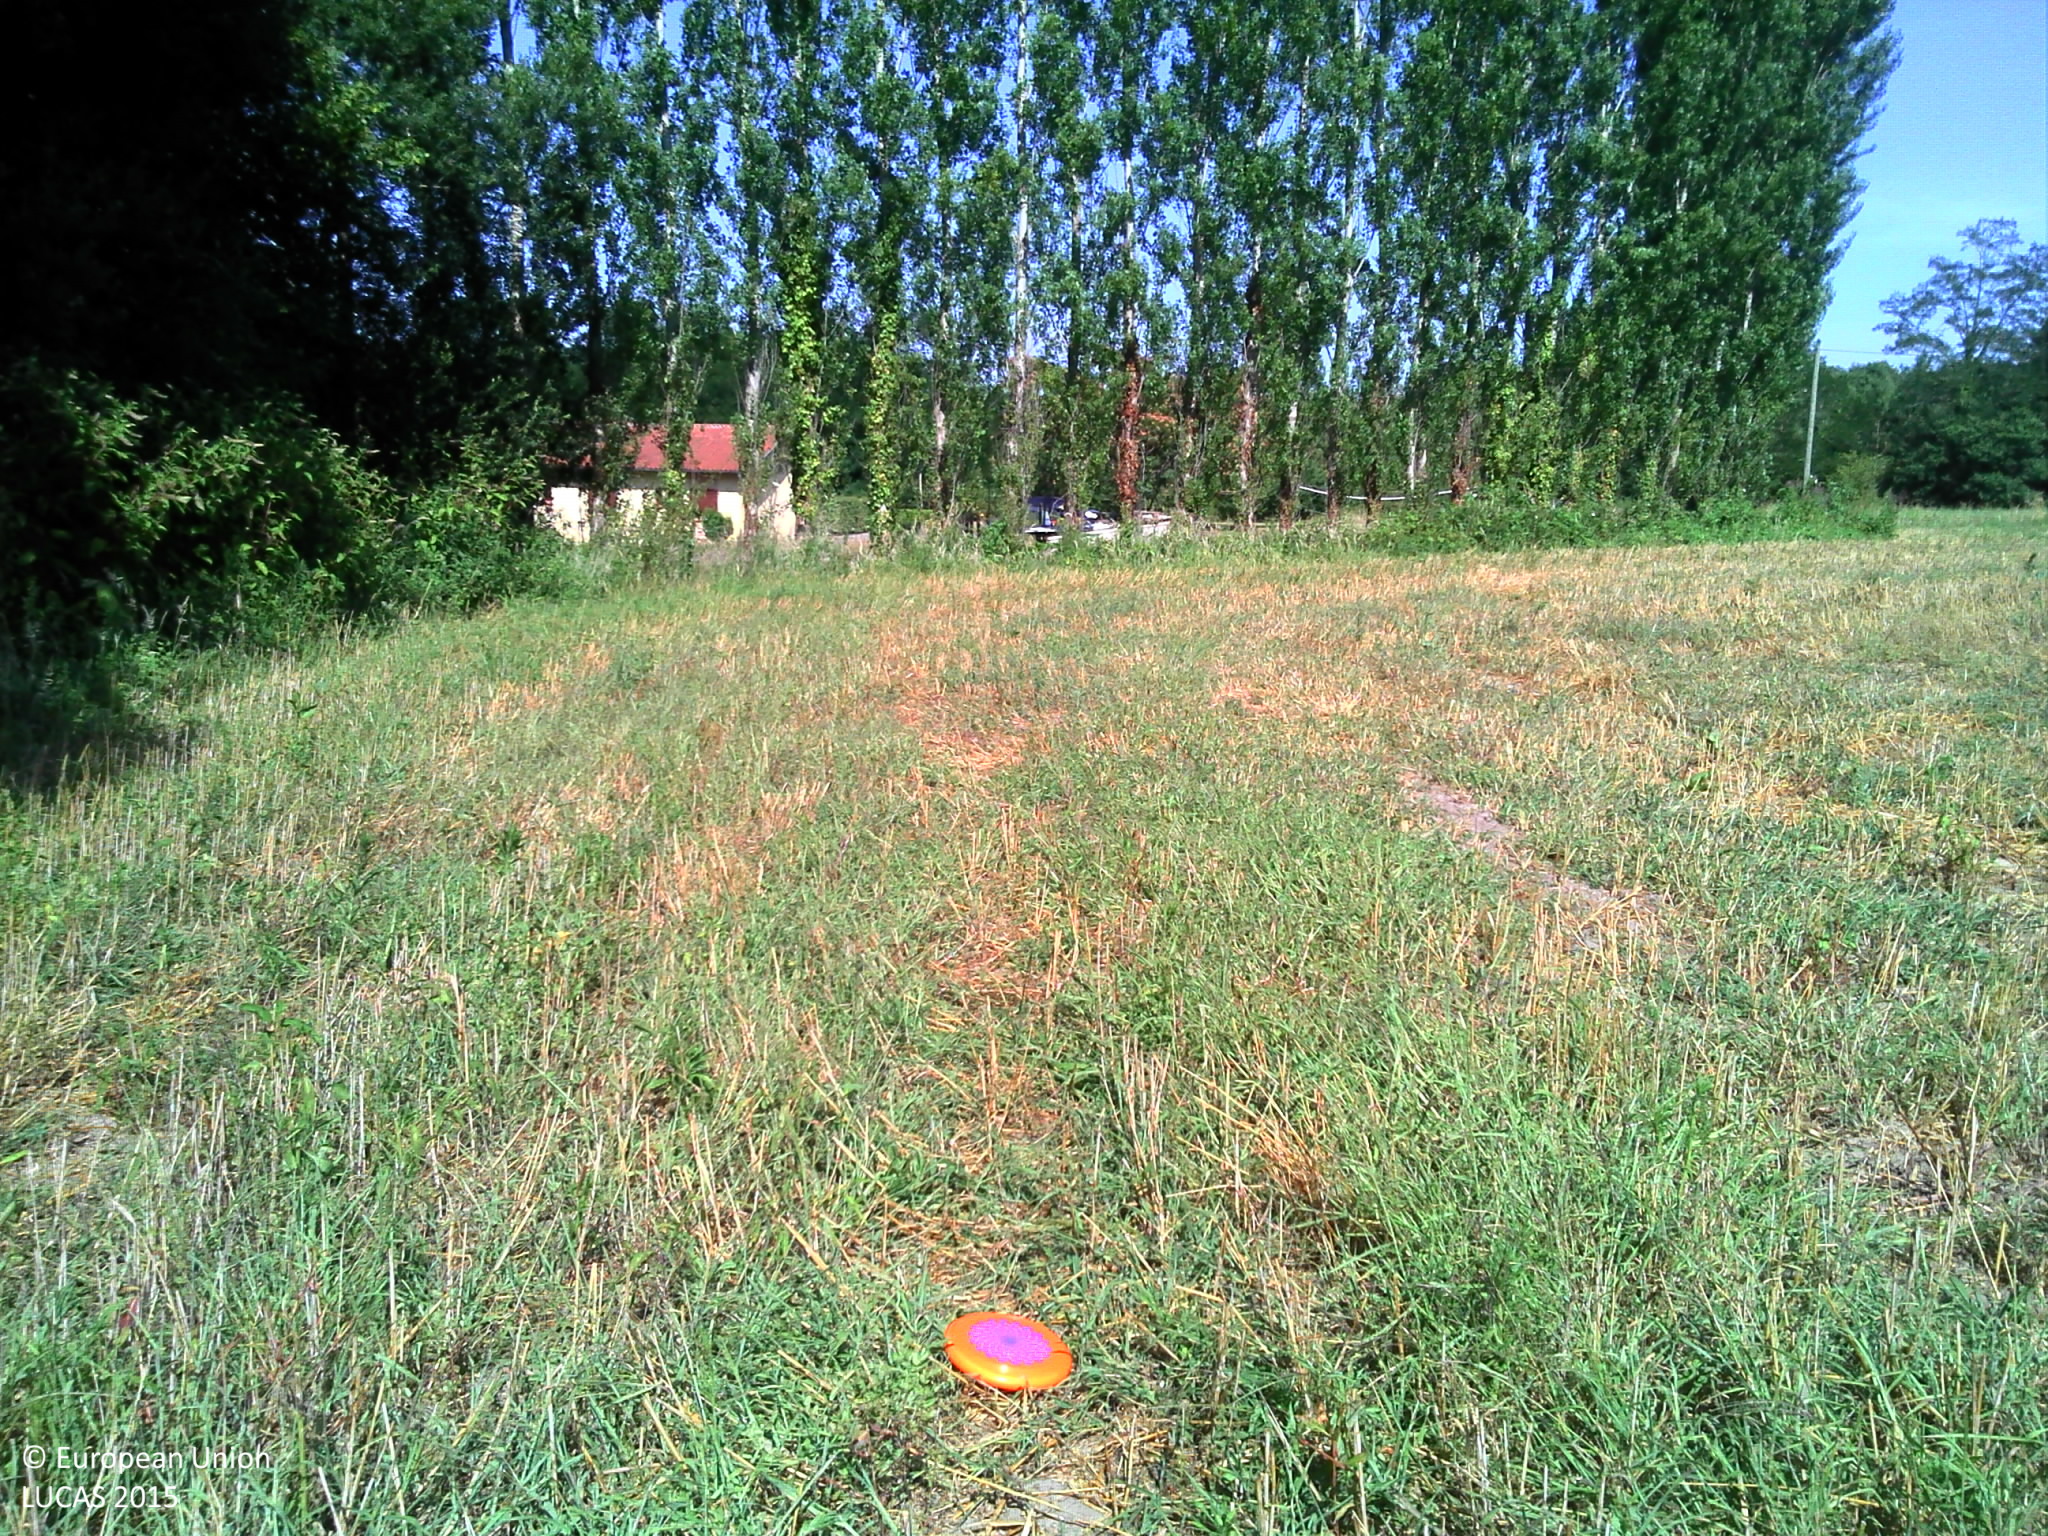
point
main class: Cropland
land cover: Temporary grasslands
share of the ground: > 75 %
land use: Agriculture (excluding fallow land and kitchen gardens)
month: July
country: FR
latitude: 43.6936
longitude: -1.1457
